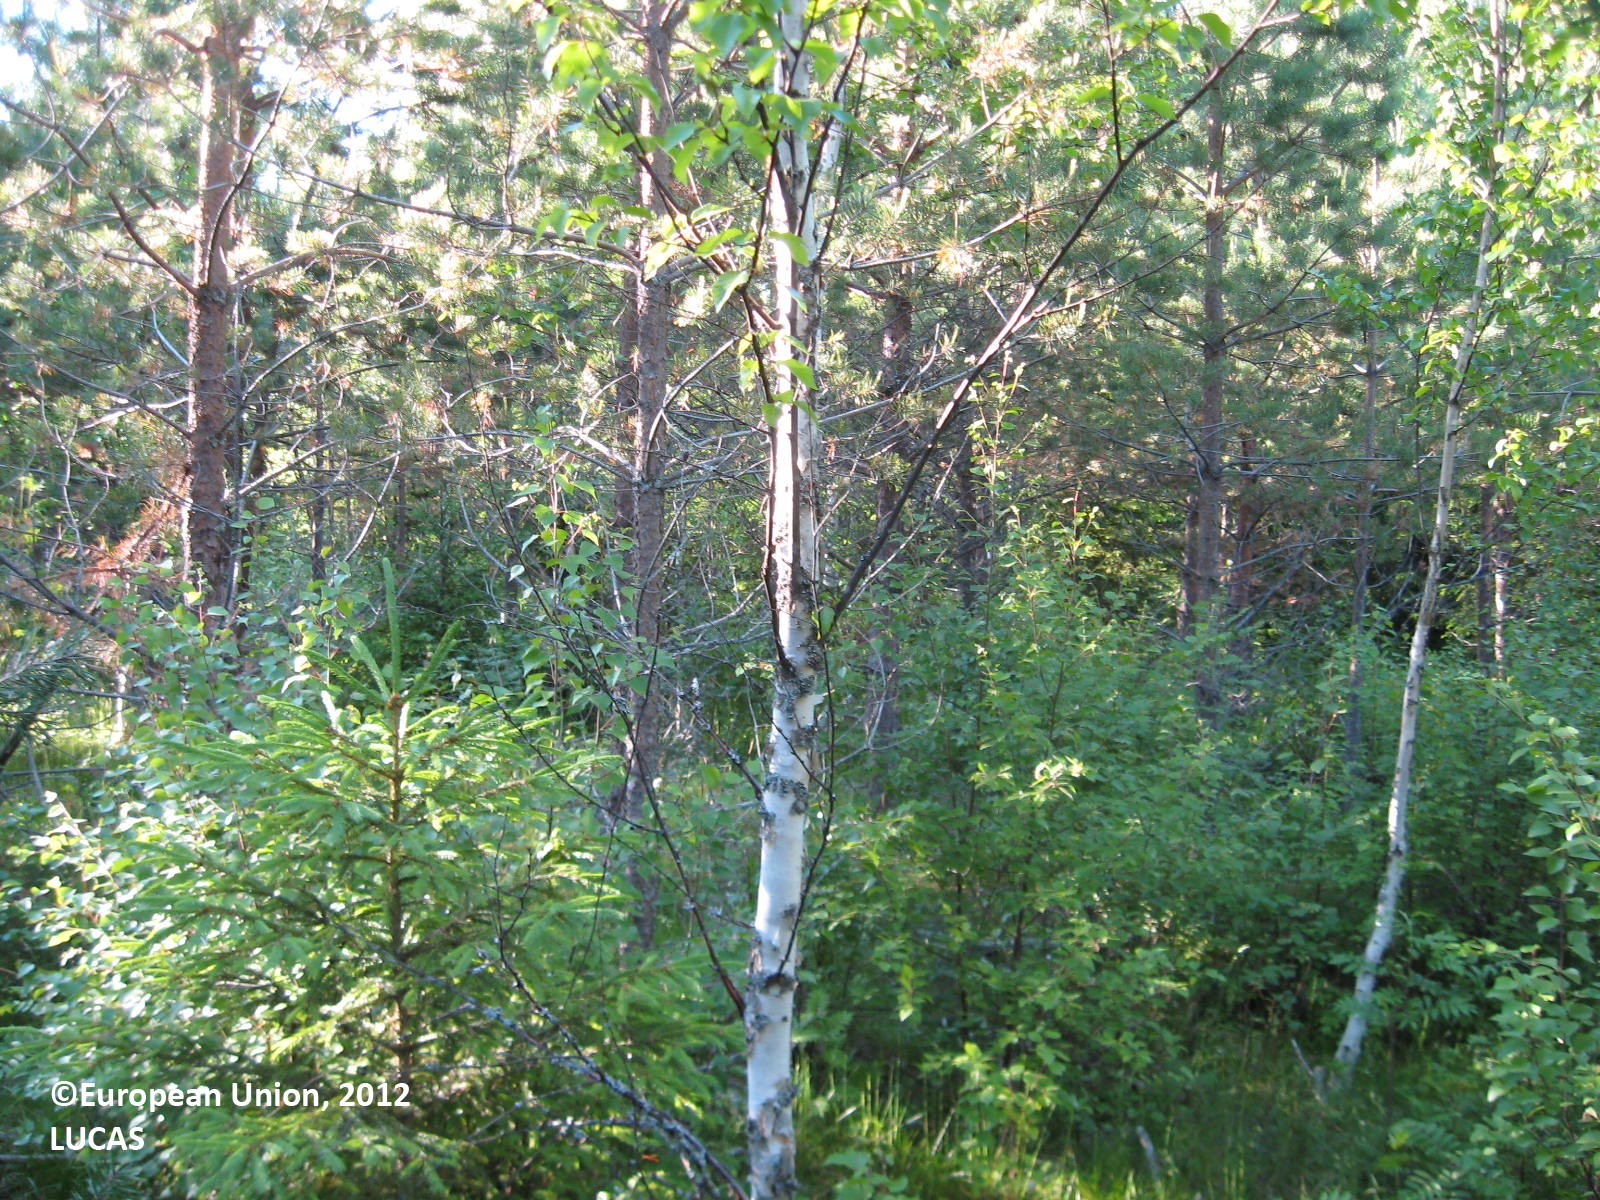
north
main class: Woodland
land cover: Pine dominated mixed woodland
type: boreal forest
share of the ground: > 75 %
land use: Forestry
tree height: > 5 m
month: June
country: FI
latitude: 62.8967
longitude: 21.7890
